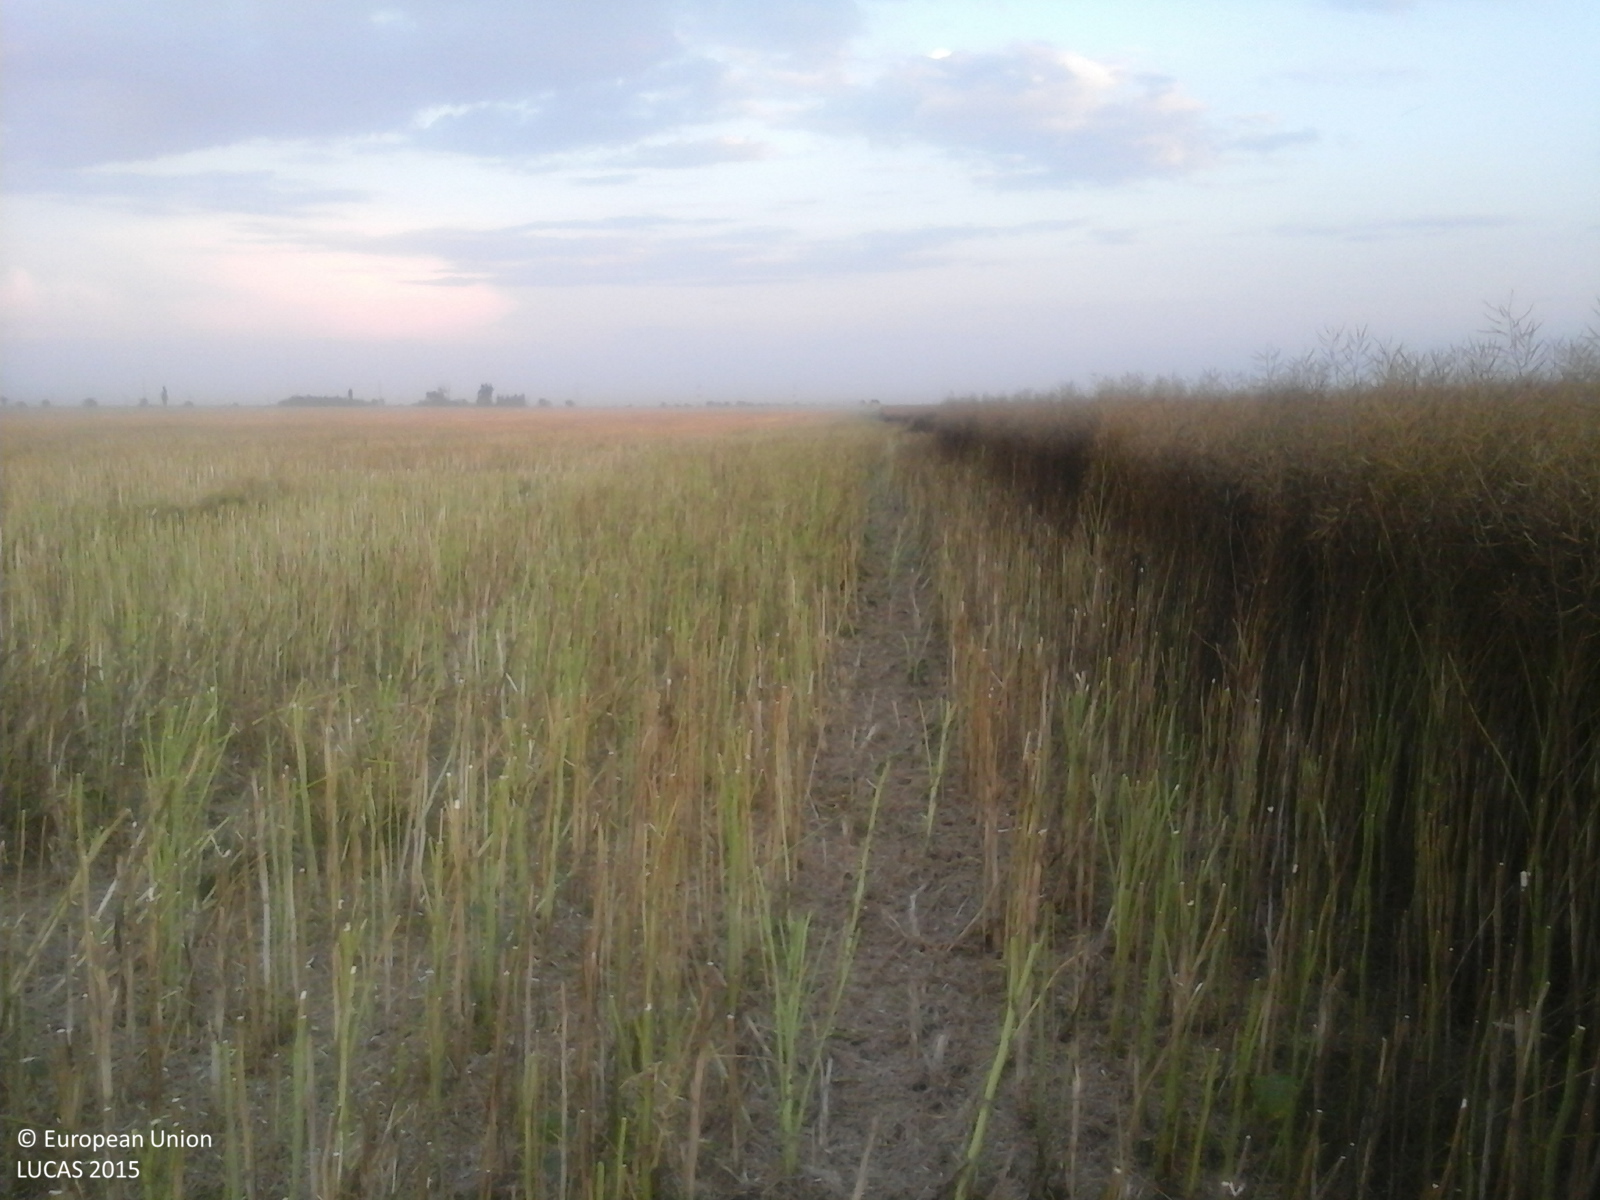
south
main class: Cropland
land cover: Rape and turnip rape
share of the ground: > 75 %
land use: Agriculture (excluding fallow land and kitchen gardens)
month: July
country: RO
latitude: 44.0359
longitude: 25.8809
